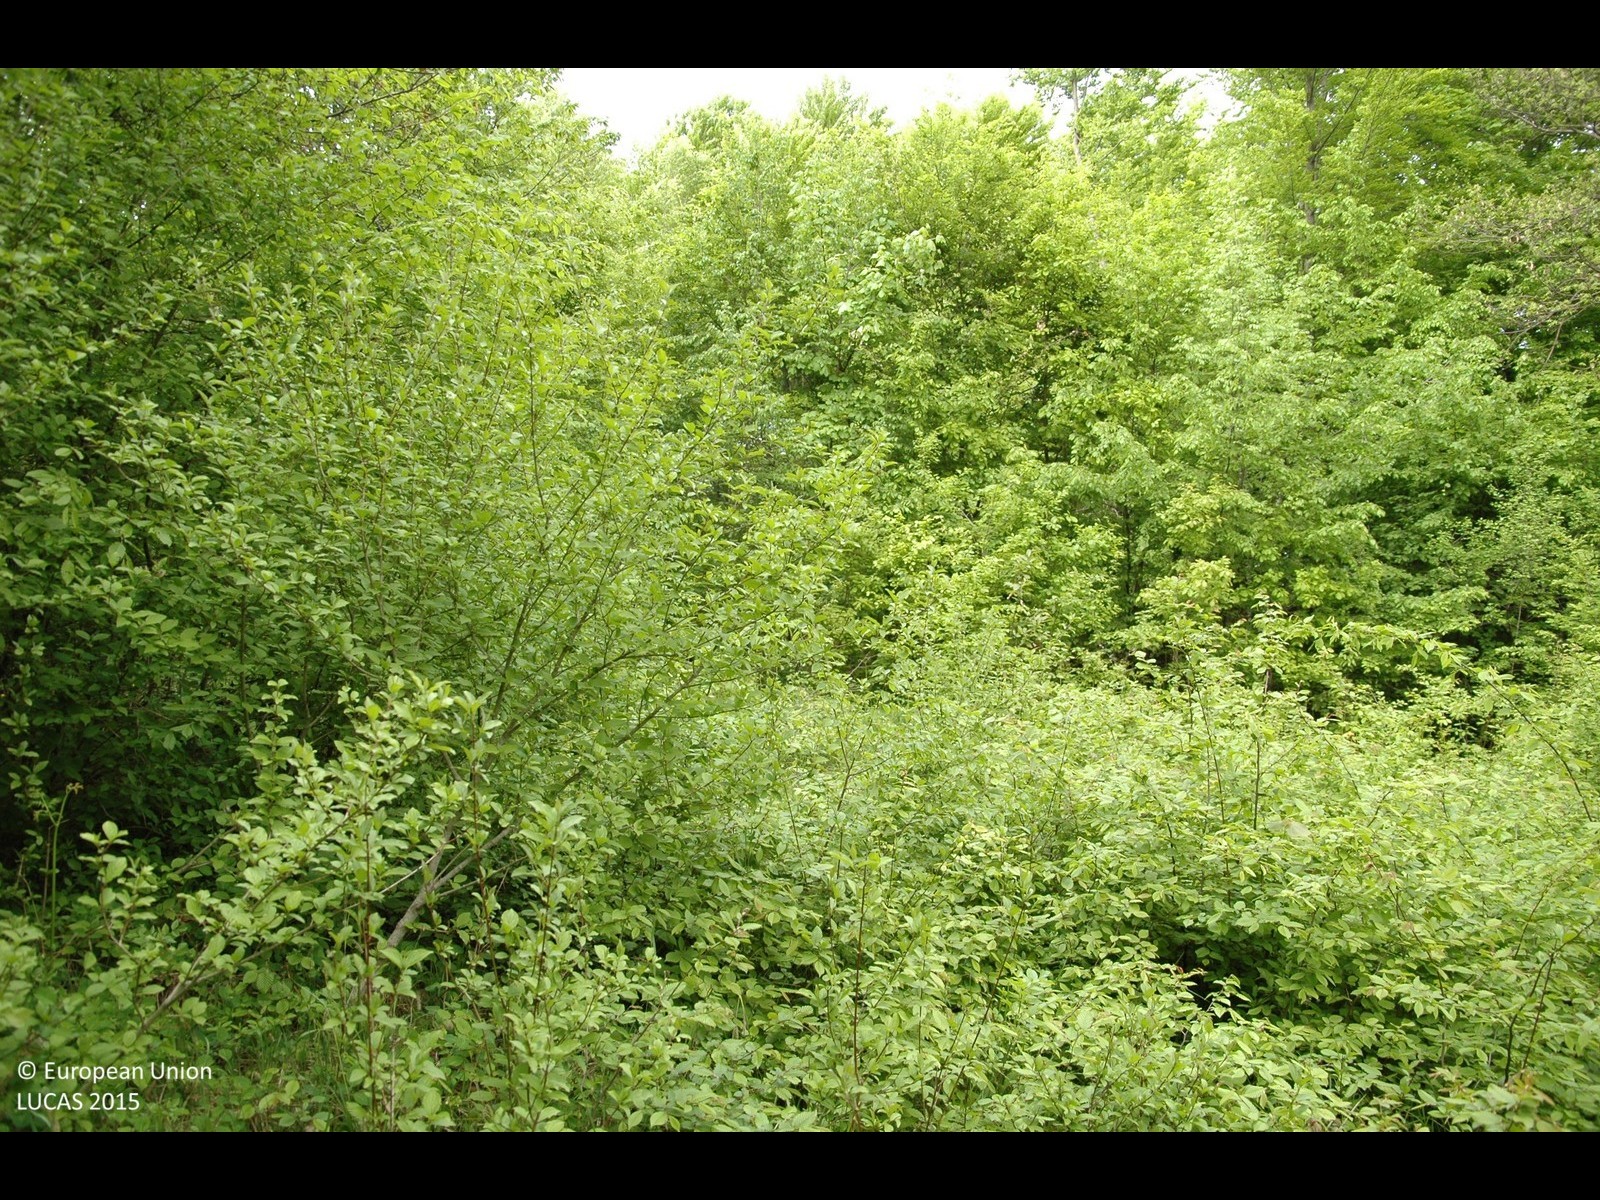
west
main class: Shrubland
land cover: Shrubland without tree cover
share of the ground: > 75 %
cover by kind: shrubs 90 %, herbaceous plants 10 %
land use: Semi-natural and natural areas not in use
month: May
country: HR
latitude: 45.8049
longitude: 15.6460
